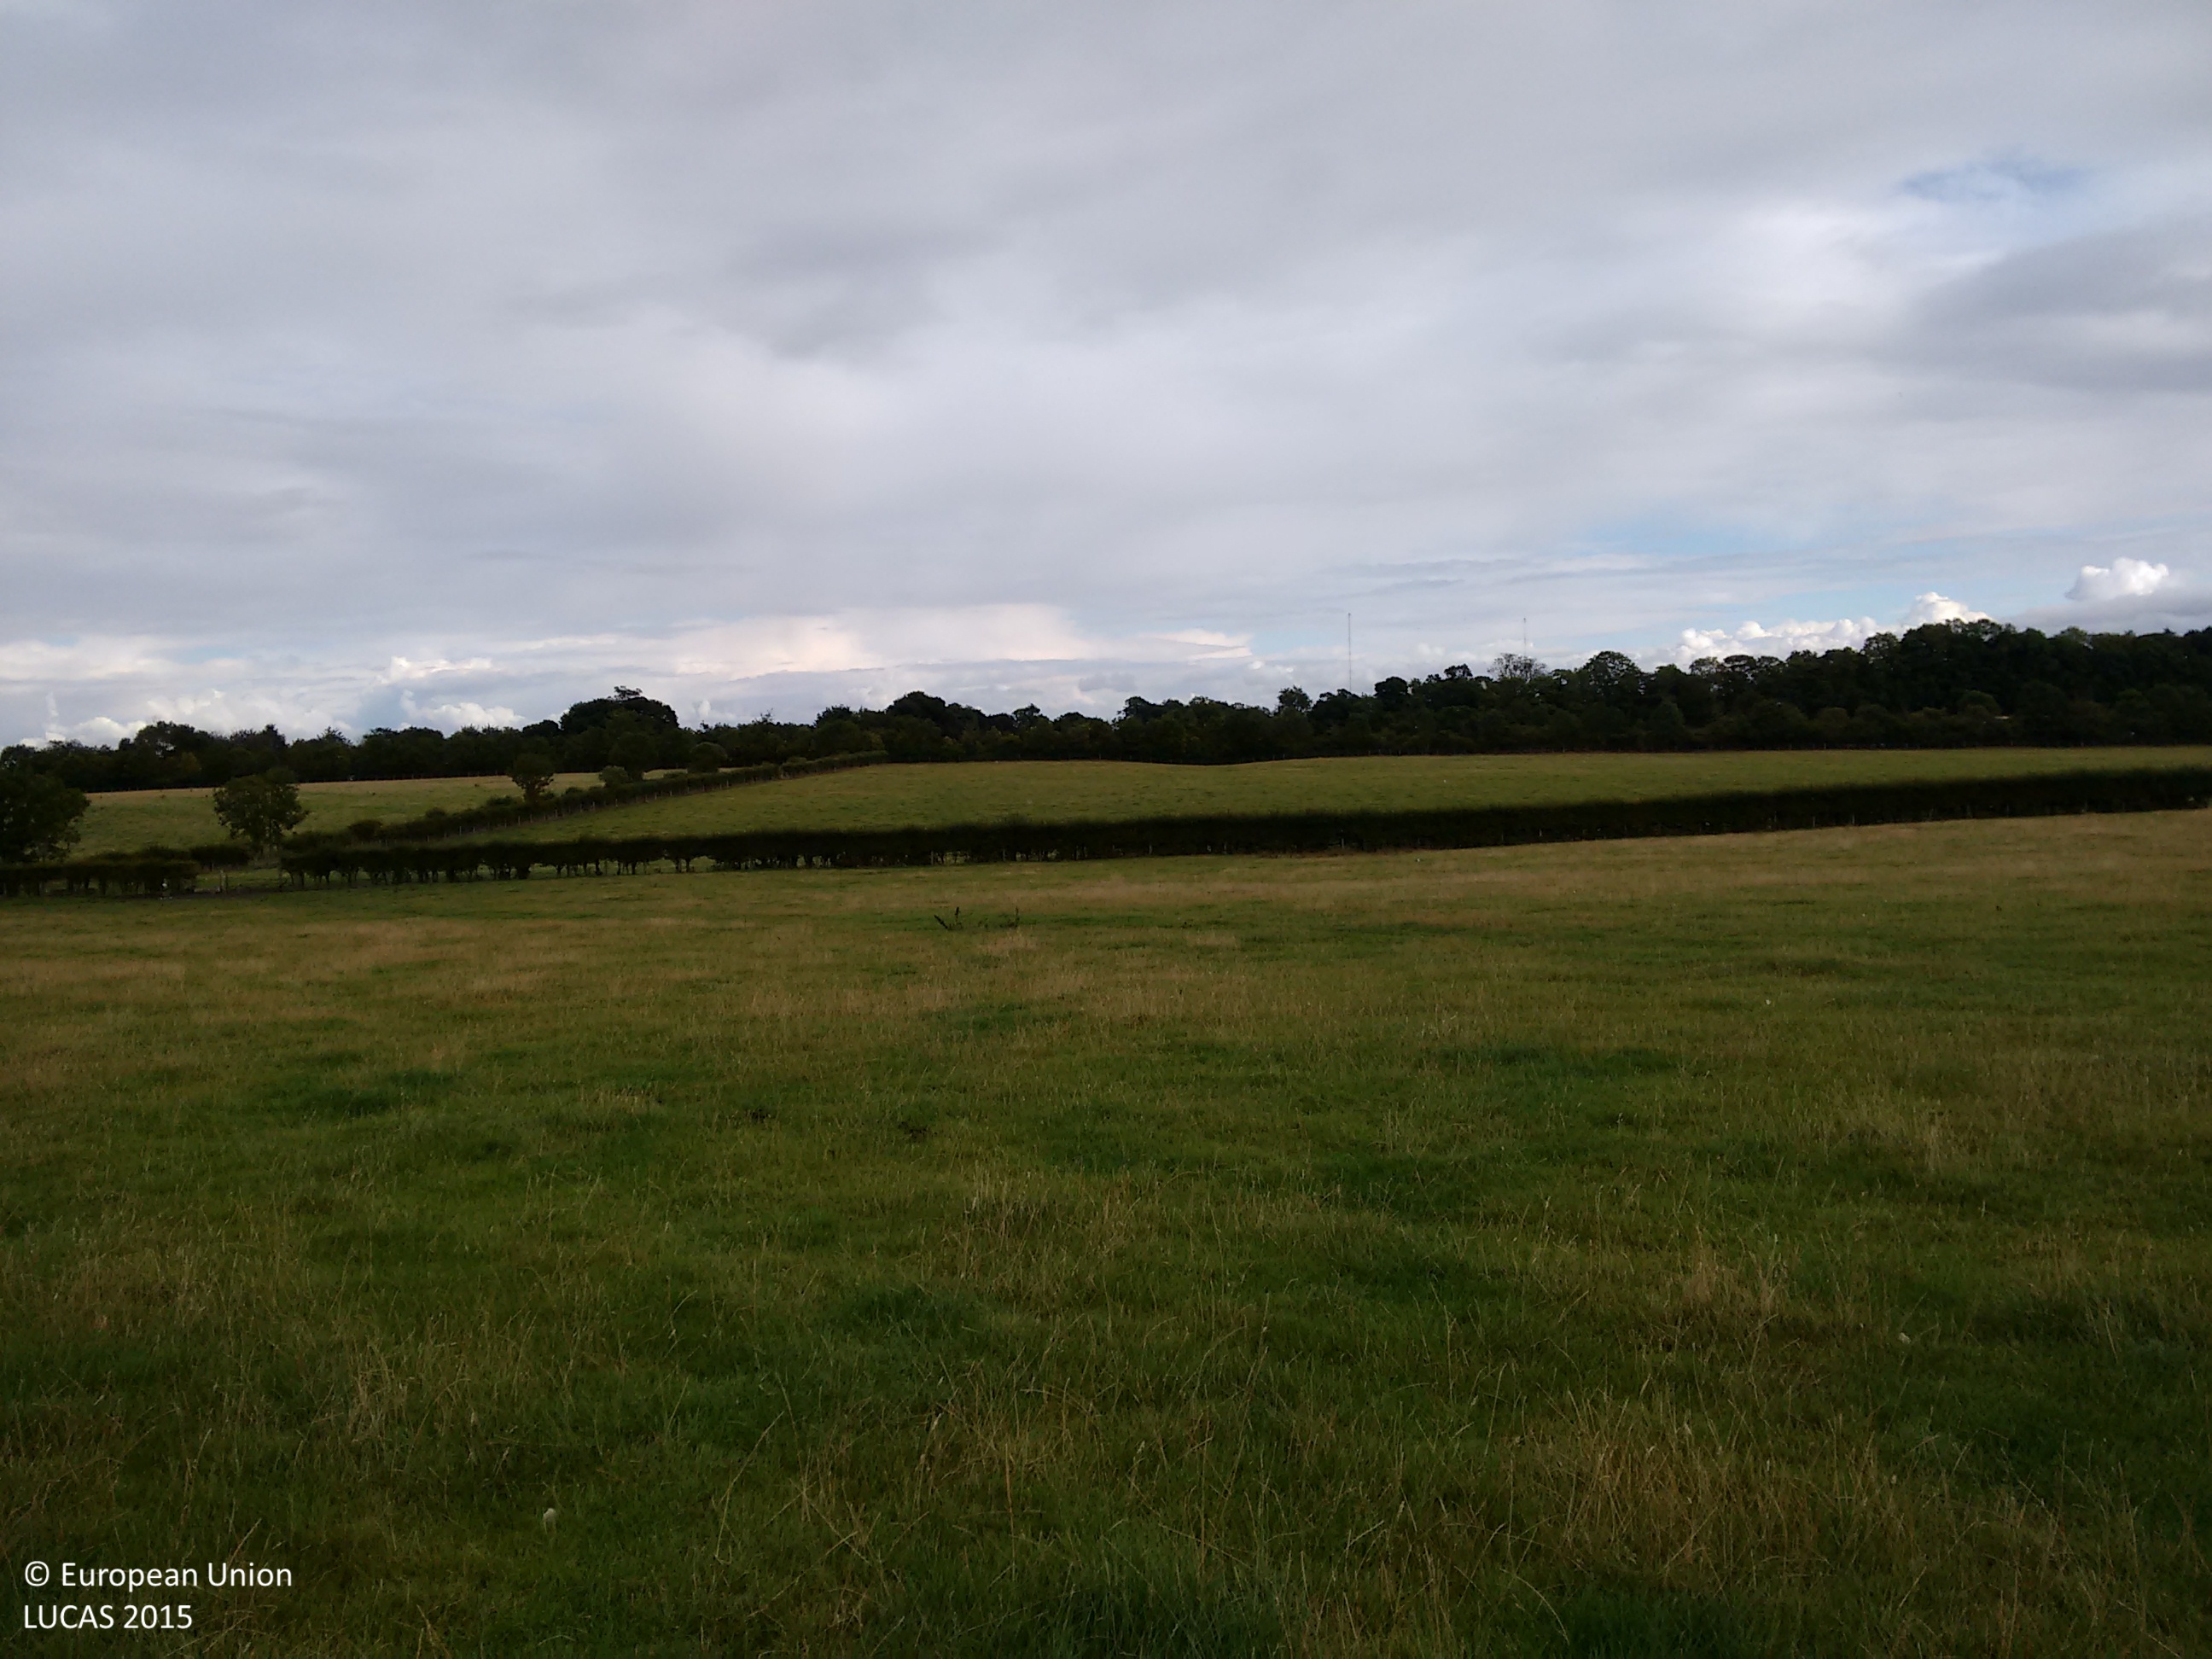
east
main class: Grassland
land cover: Grassland without tree/shrub cover
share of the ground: > 75 %
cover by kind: herbaceous plants 100 %
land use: Agriculture (excluding fallow land and kitchen gardens)
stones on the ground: < 10 %
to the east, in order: Grassland without tree/shrub cover; Managed hedges; Grassland without tree/shrub cover; Artificial constructions; Grassland without tree/shrub cover
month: September
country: GB
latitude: 53.0396
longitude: -3.0358
